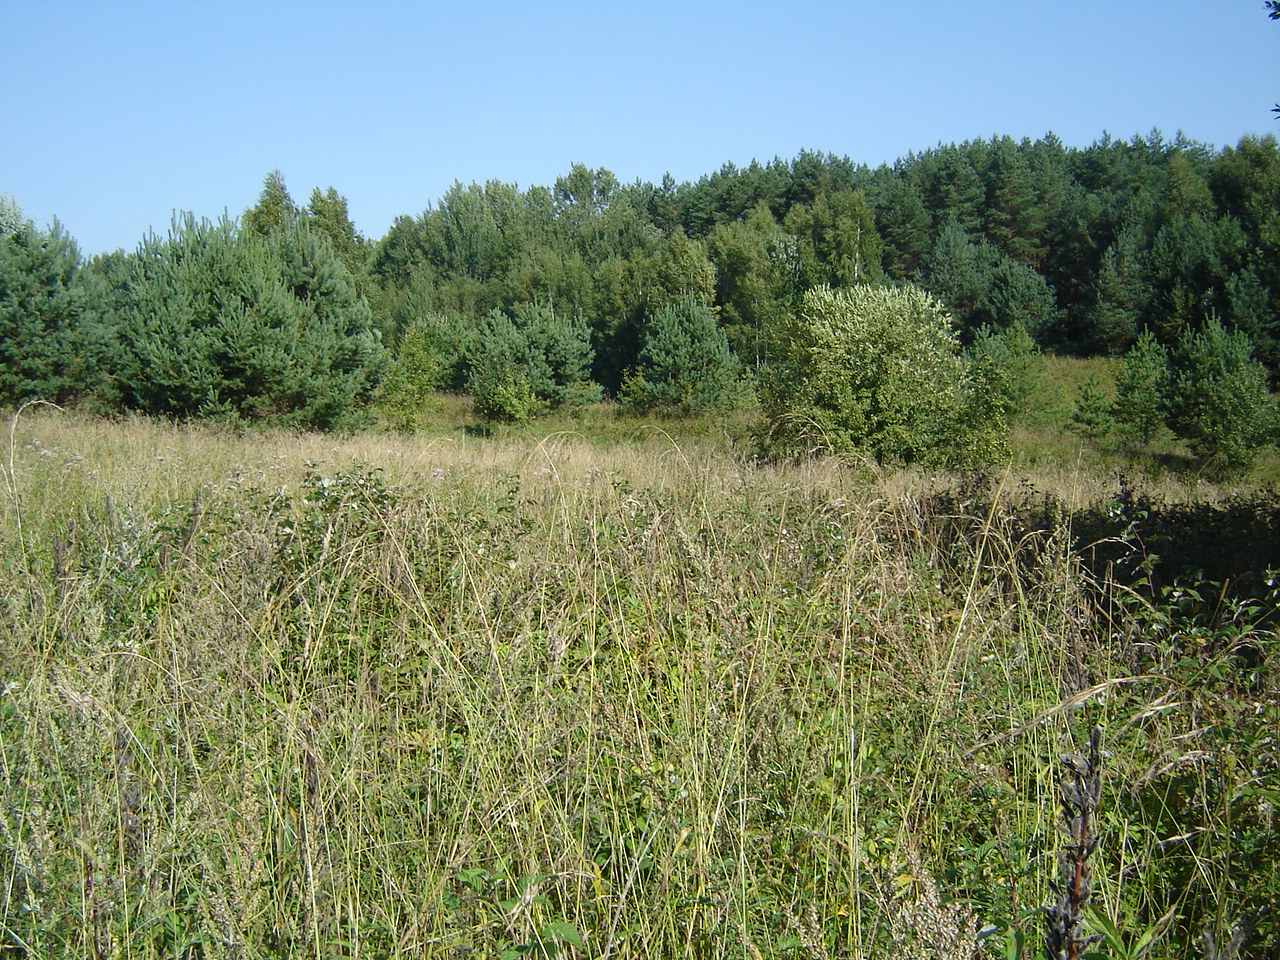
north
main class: Woodland
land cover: Pine dominated mixed woodland
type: hemiboreal forest and nemoral coniferous forest and mixed broadleaved-coniferous forest
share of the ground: > 75 %
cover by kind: coniferous forest trees 45 %, broadleaved forest trees 45 %, herbaceous plants 10 %
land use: Forestry
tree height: > 5 m
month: August
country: LT
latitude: 54.8858
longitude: 24.7775
